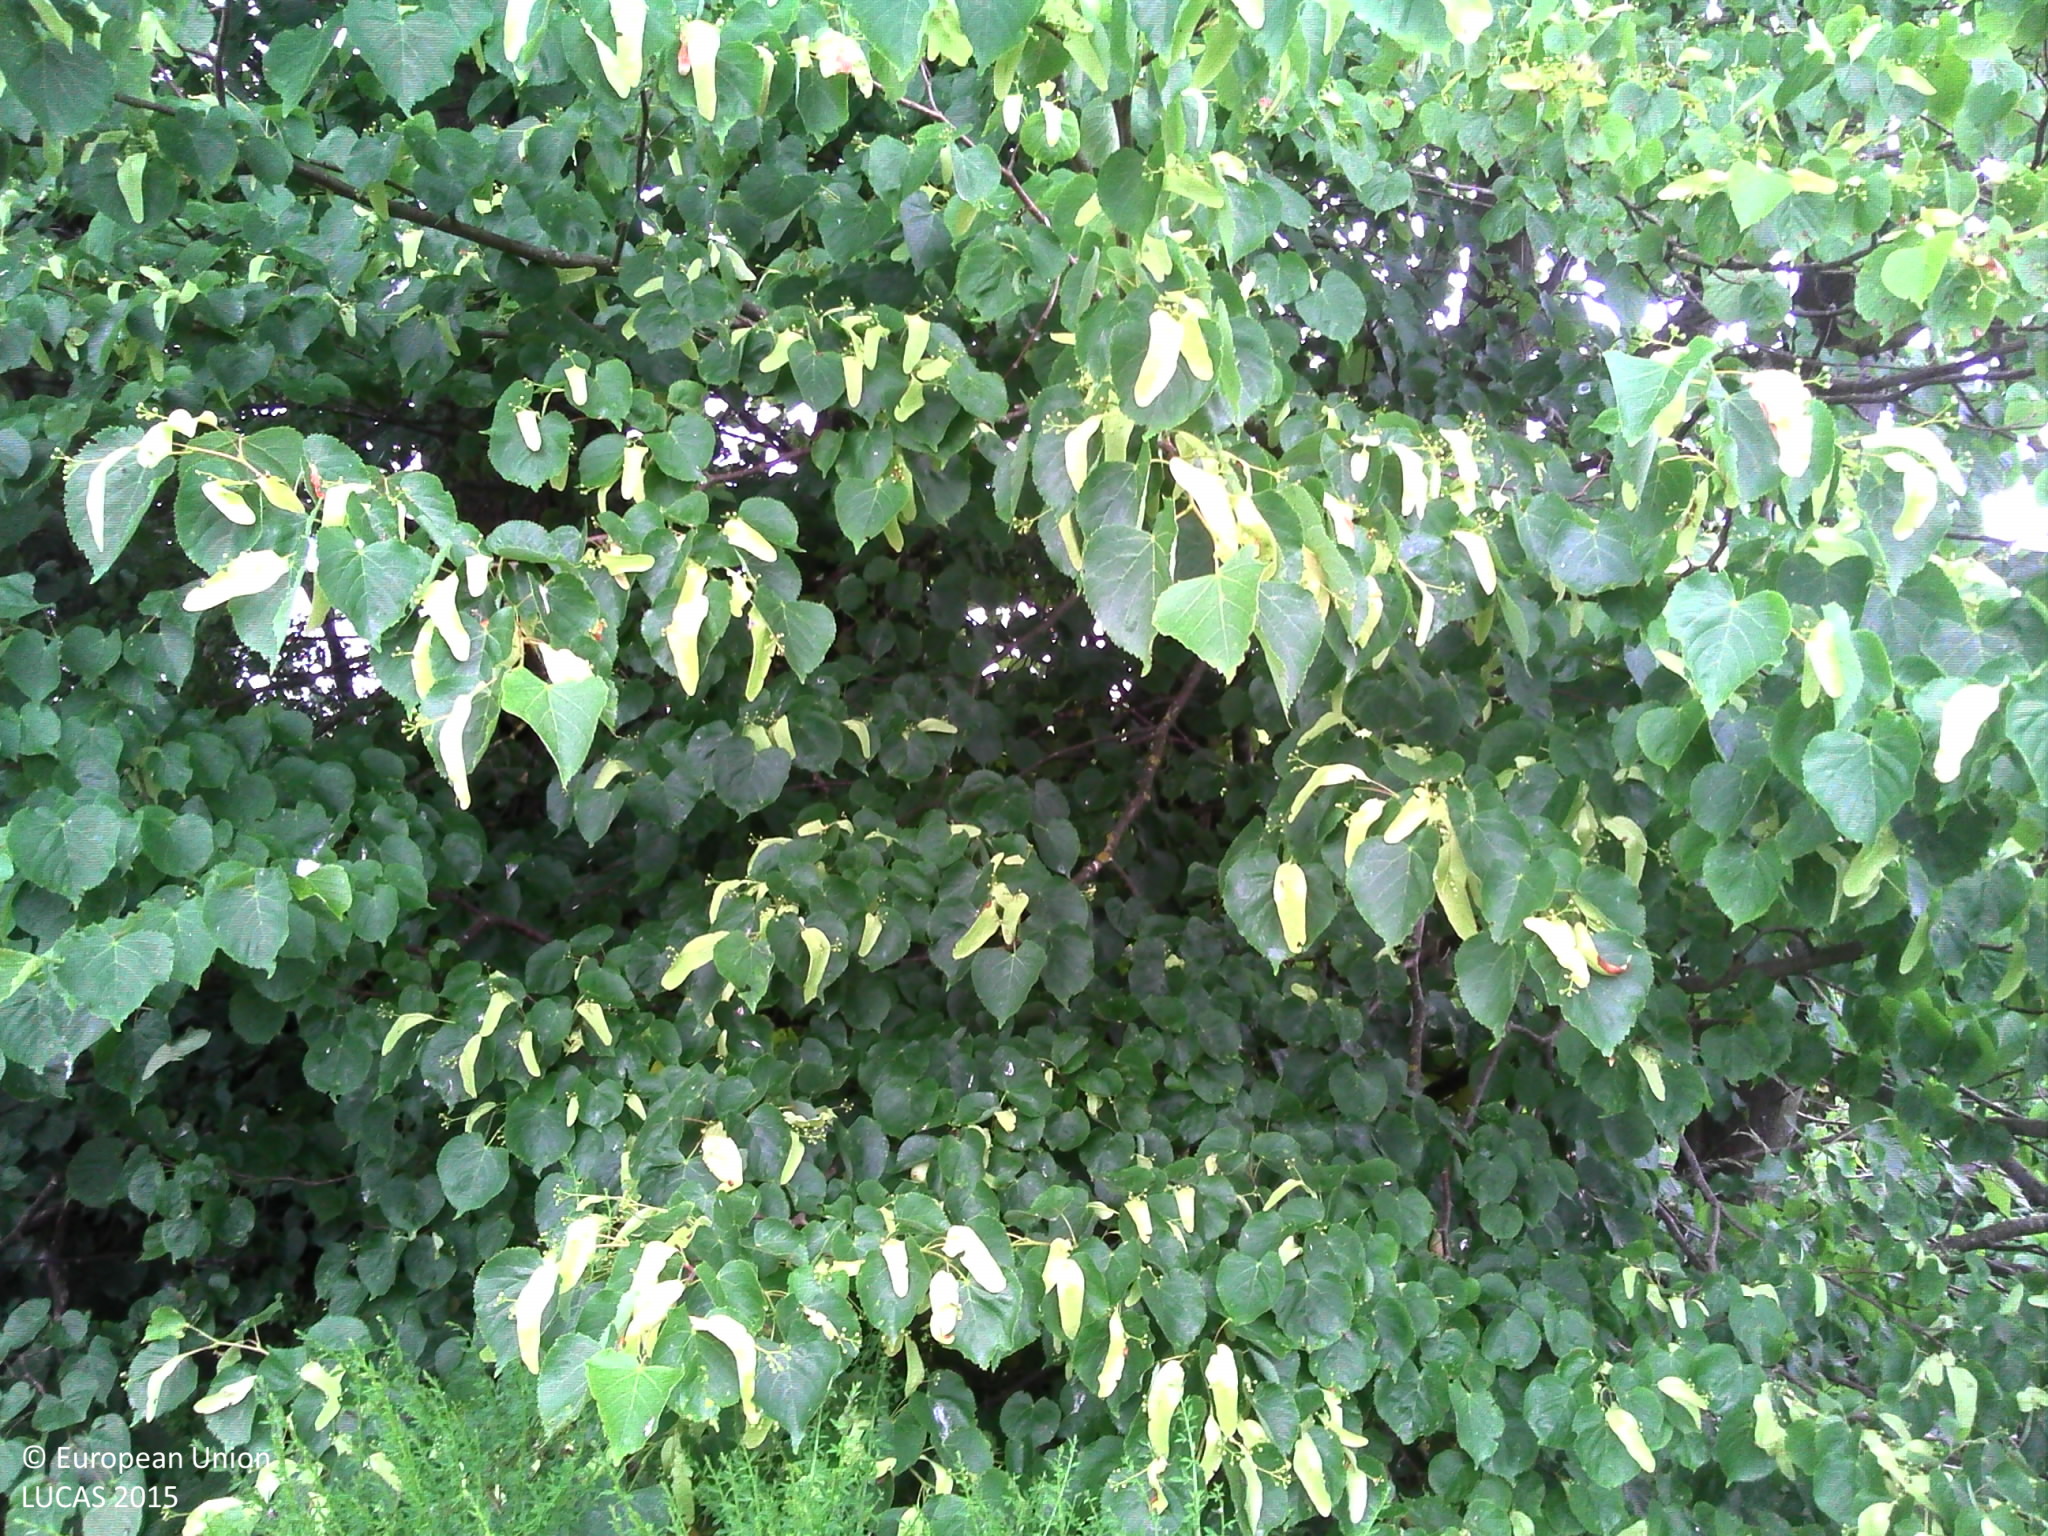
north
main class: Cropland
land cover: Rape and turnip rape
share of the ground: > 75 %
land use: Agriculture (excluding fallow land and kitchen gardens)
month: June
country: FR
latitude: 46.1221
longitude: 4.9170
